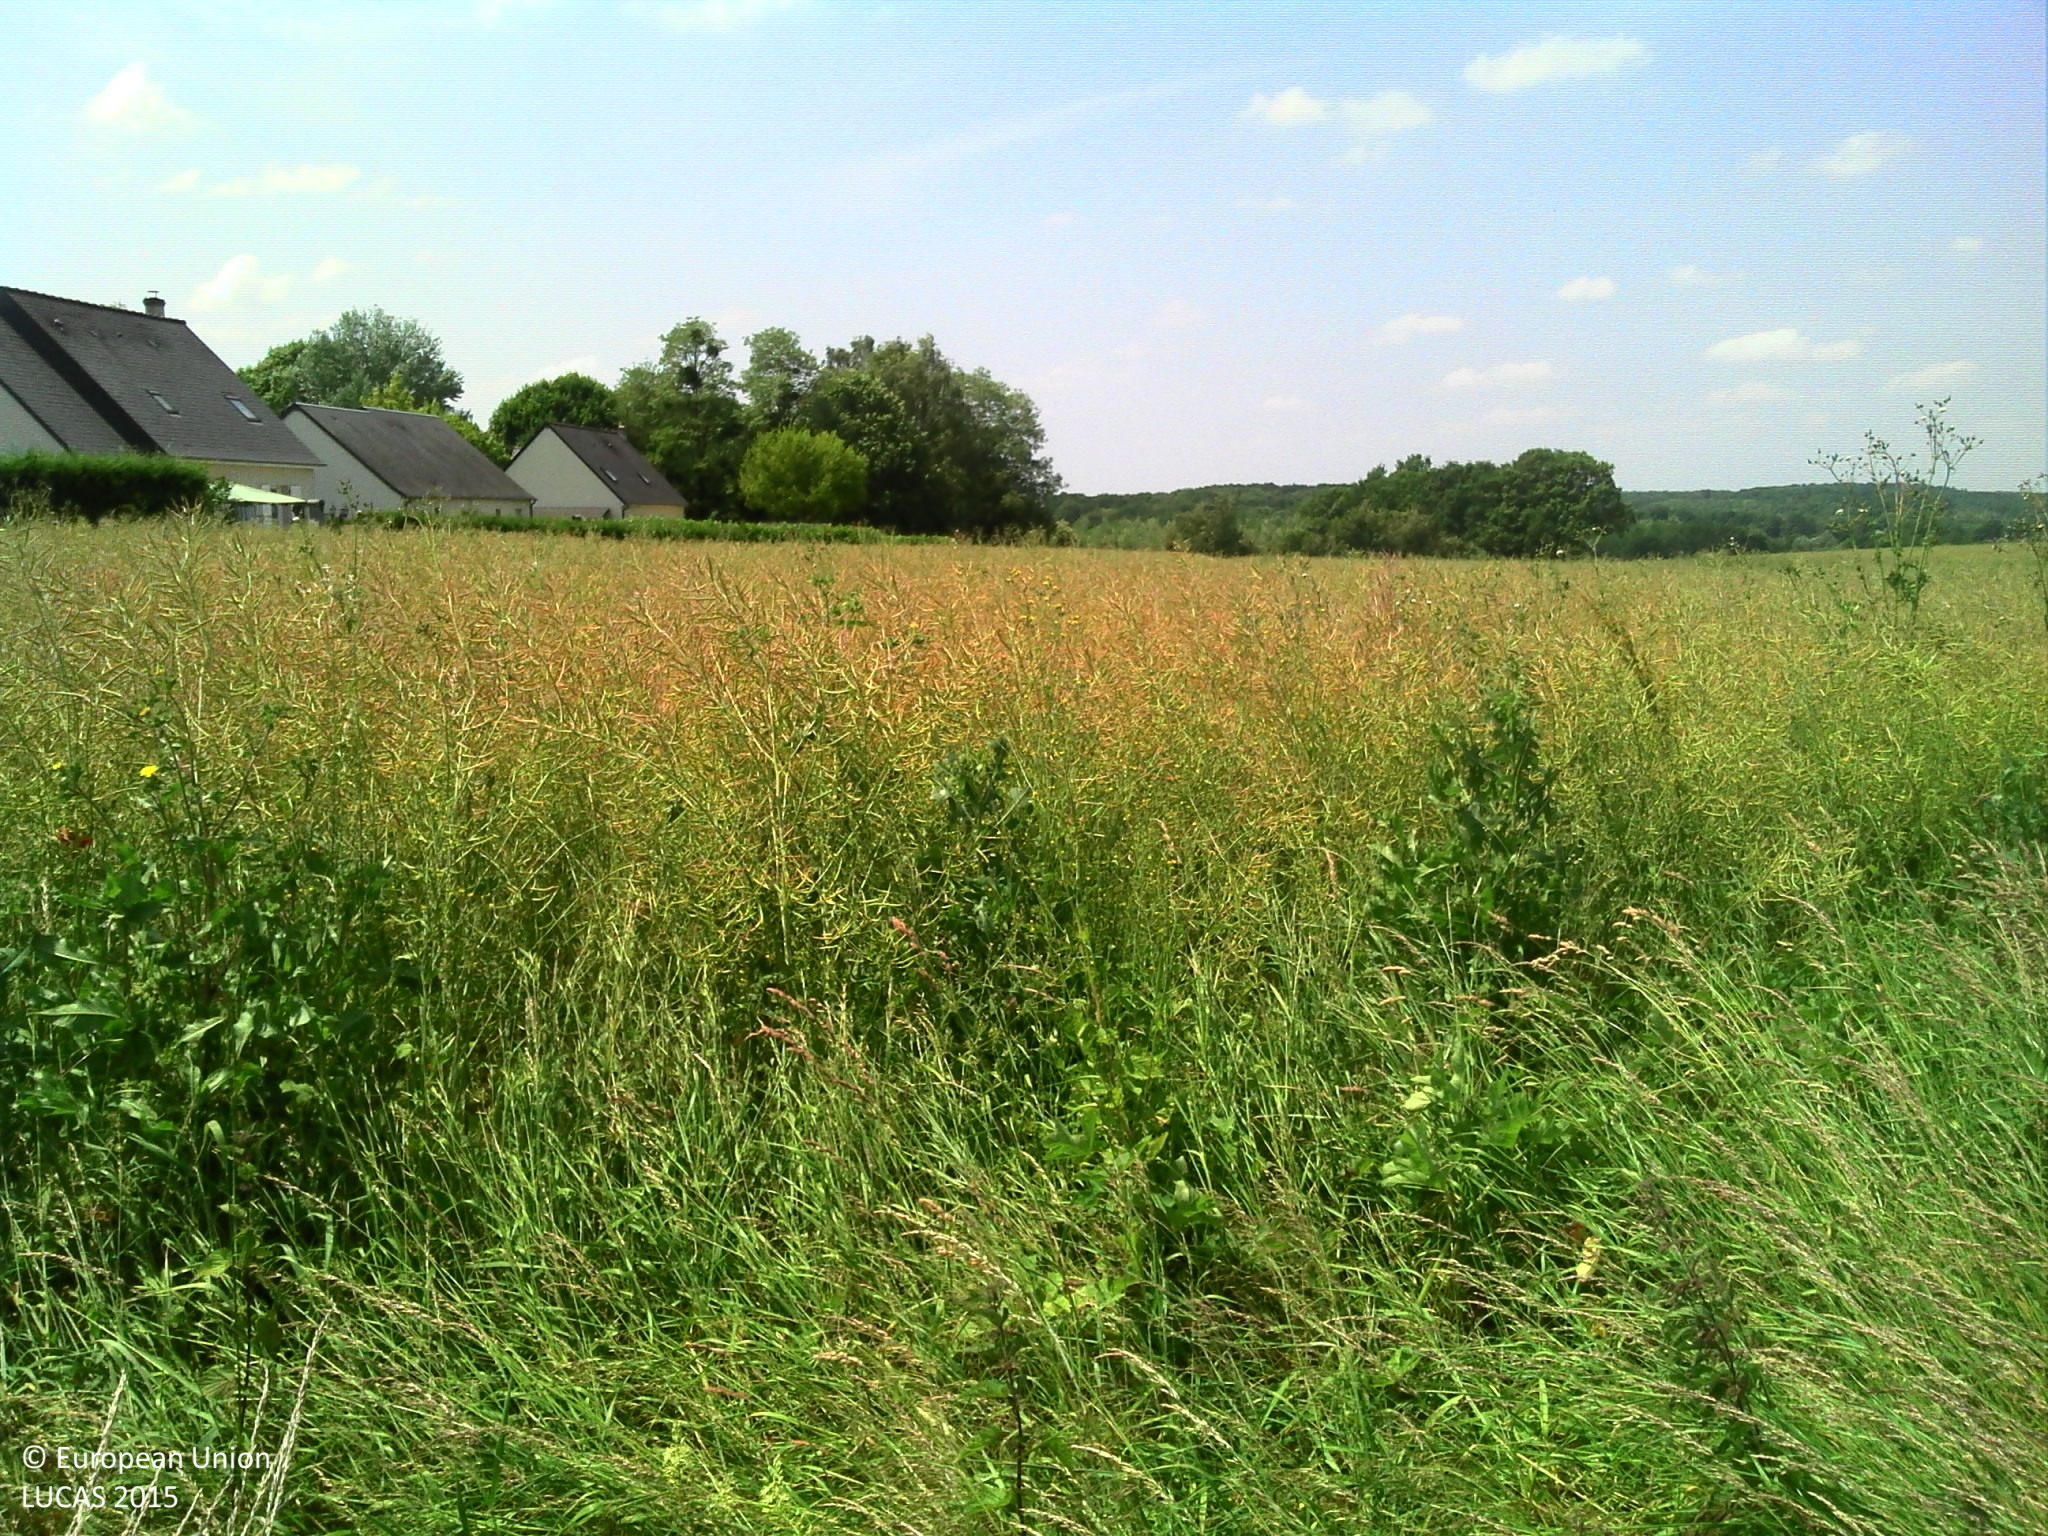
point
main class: Cropland
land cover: Rape and turnip rape
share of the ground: > 75 %
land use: Agriculture (excluding fallow land and kitchen gardens)
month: June
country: FR
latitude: 47.6619
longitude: 0.6446
